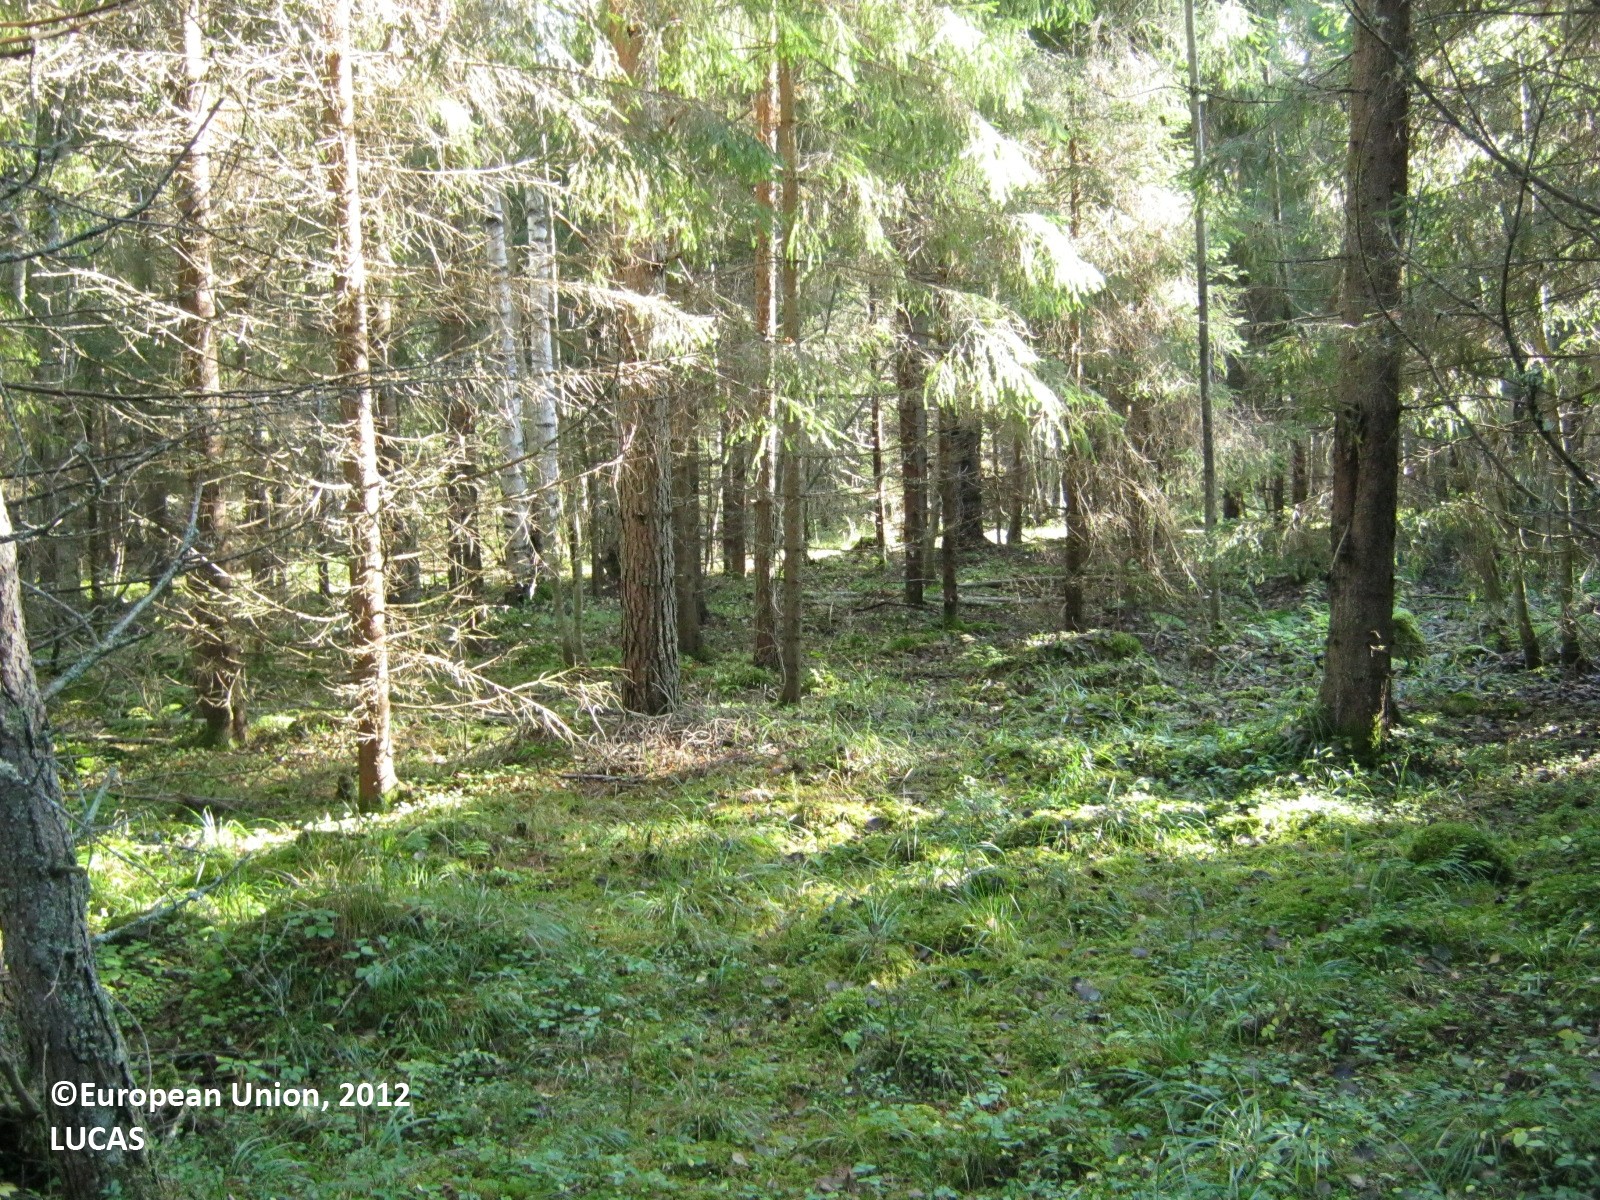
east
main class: Woodland
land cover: Spruce dominated mixed woodland
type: boreal forest
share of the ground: 50 - 75 %
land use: Forestry
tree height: > 5 m
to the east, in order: Spruce dominated mixed woodland; Ditches and canals; Spruce dominated coniferous woodland; Ditches and canals; Other mixed woodland; Ditches and canals; Grass margins; Paved roads, cycling and walking lanes; Grass margins; Ditches and canals; Other coniferous woodland
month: September
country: FI
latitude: 62.5227
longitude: 27.7972
